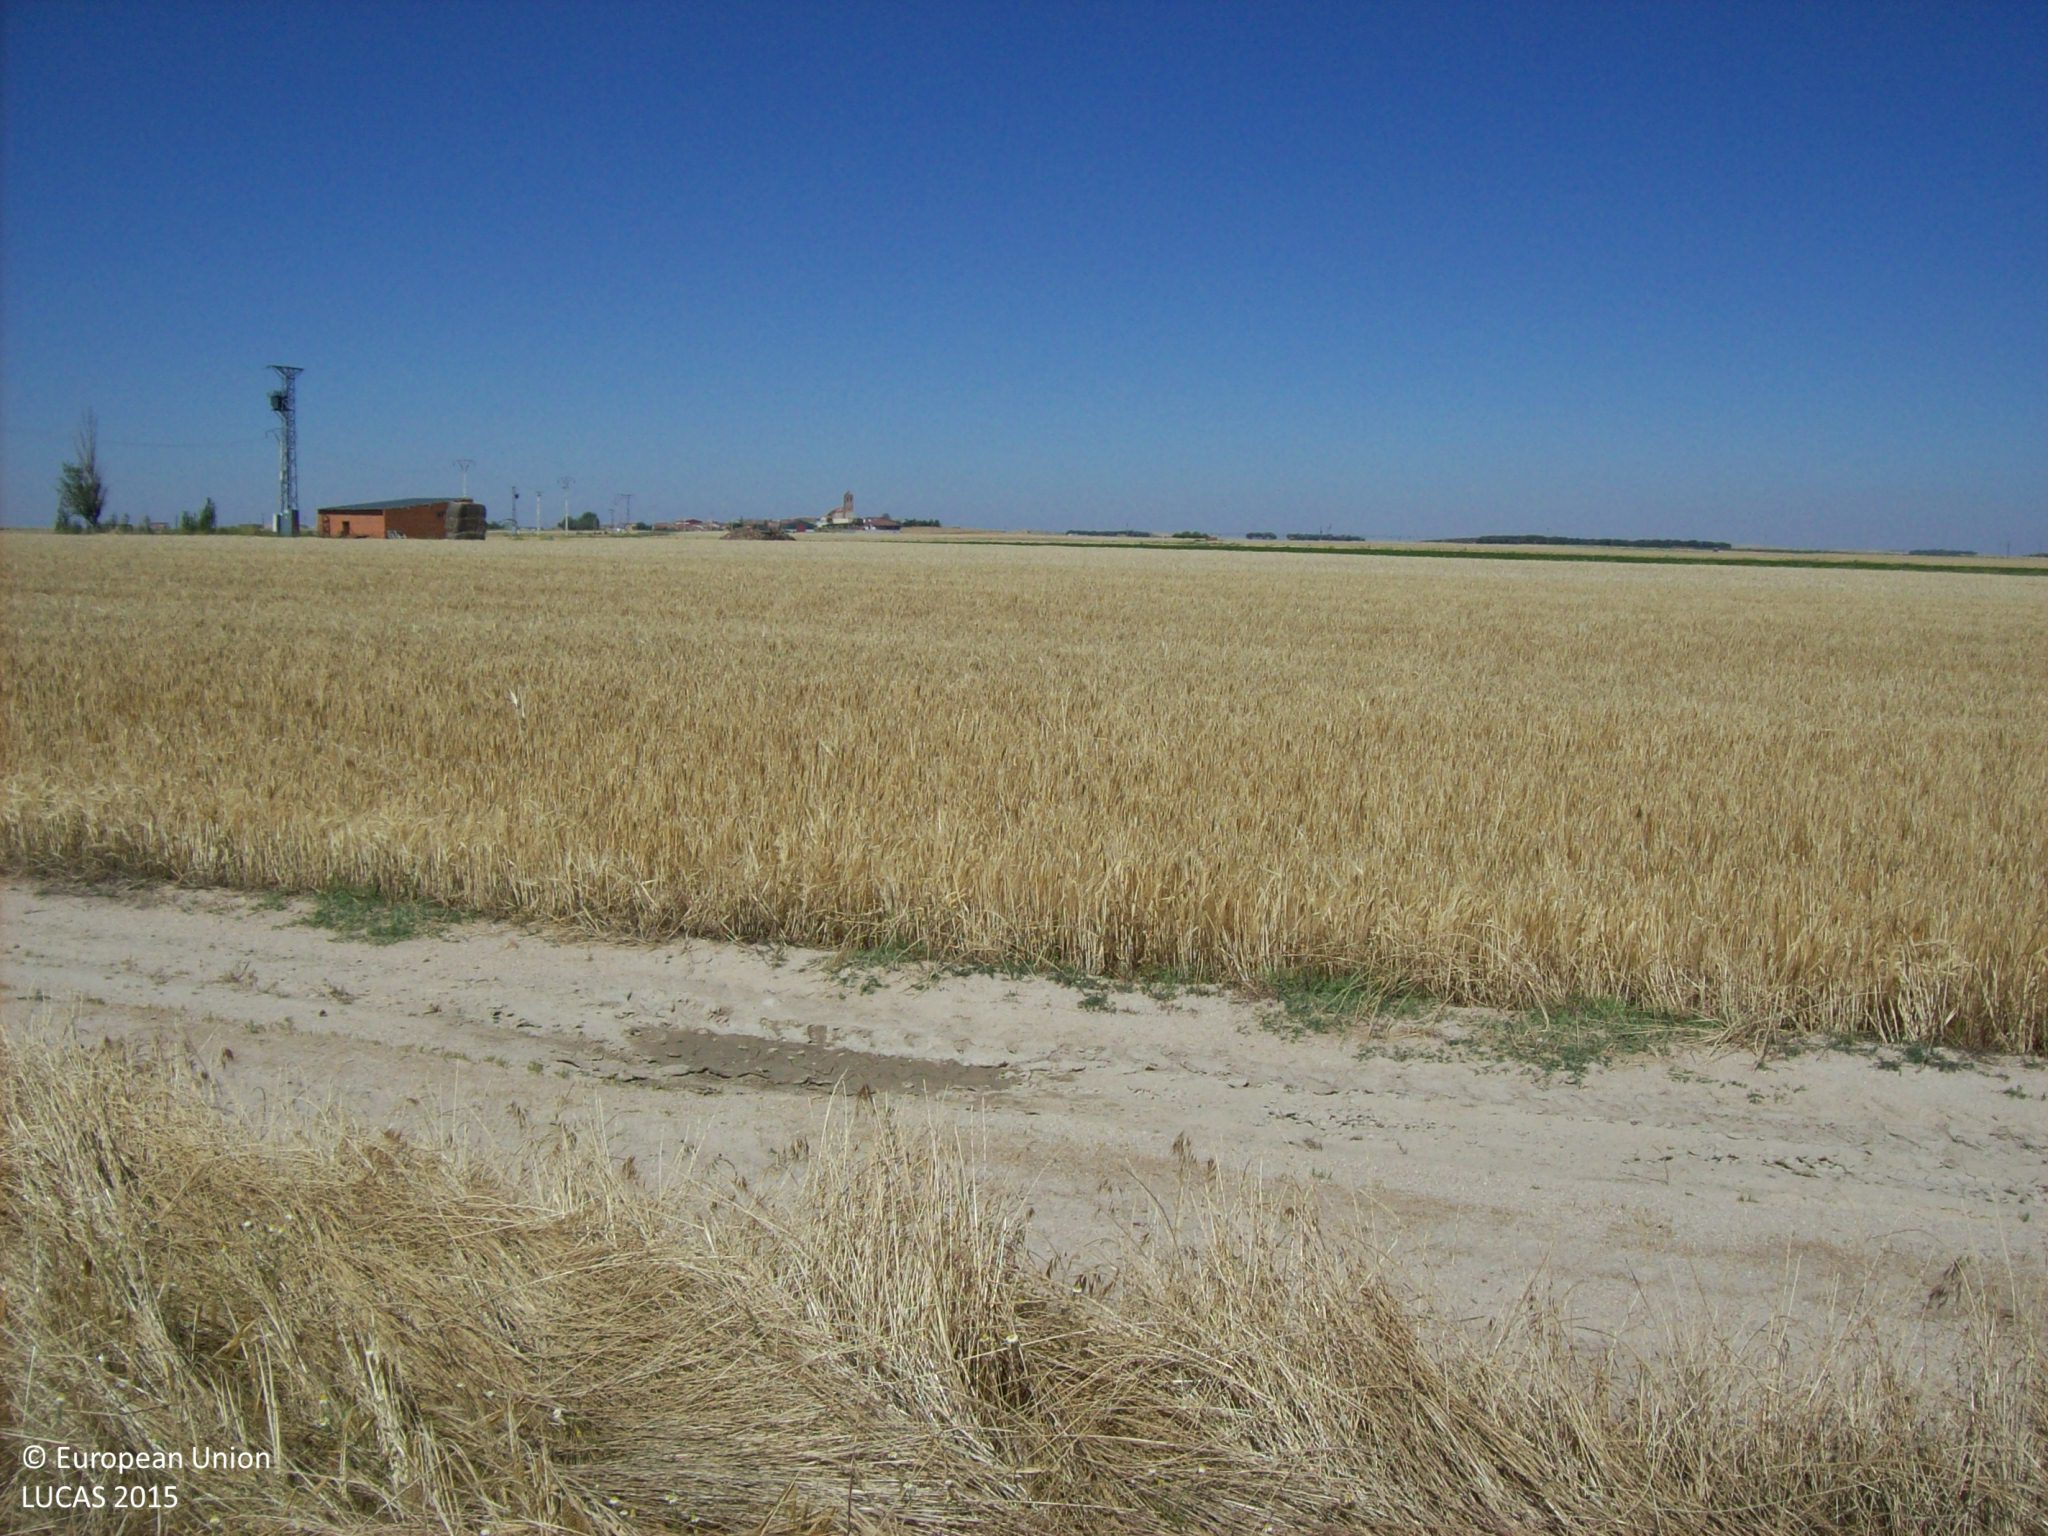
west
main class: Cropland
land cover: Barley
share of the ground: > 75 %
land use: Agriculture (excluding fallow land and kitchen gardens)
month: June
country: ES
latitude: 41.2335
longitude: -5.0180
